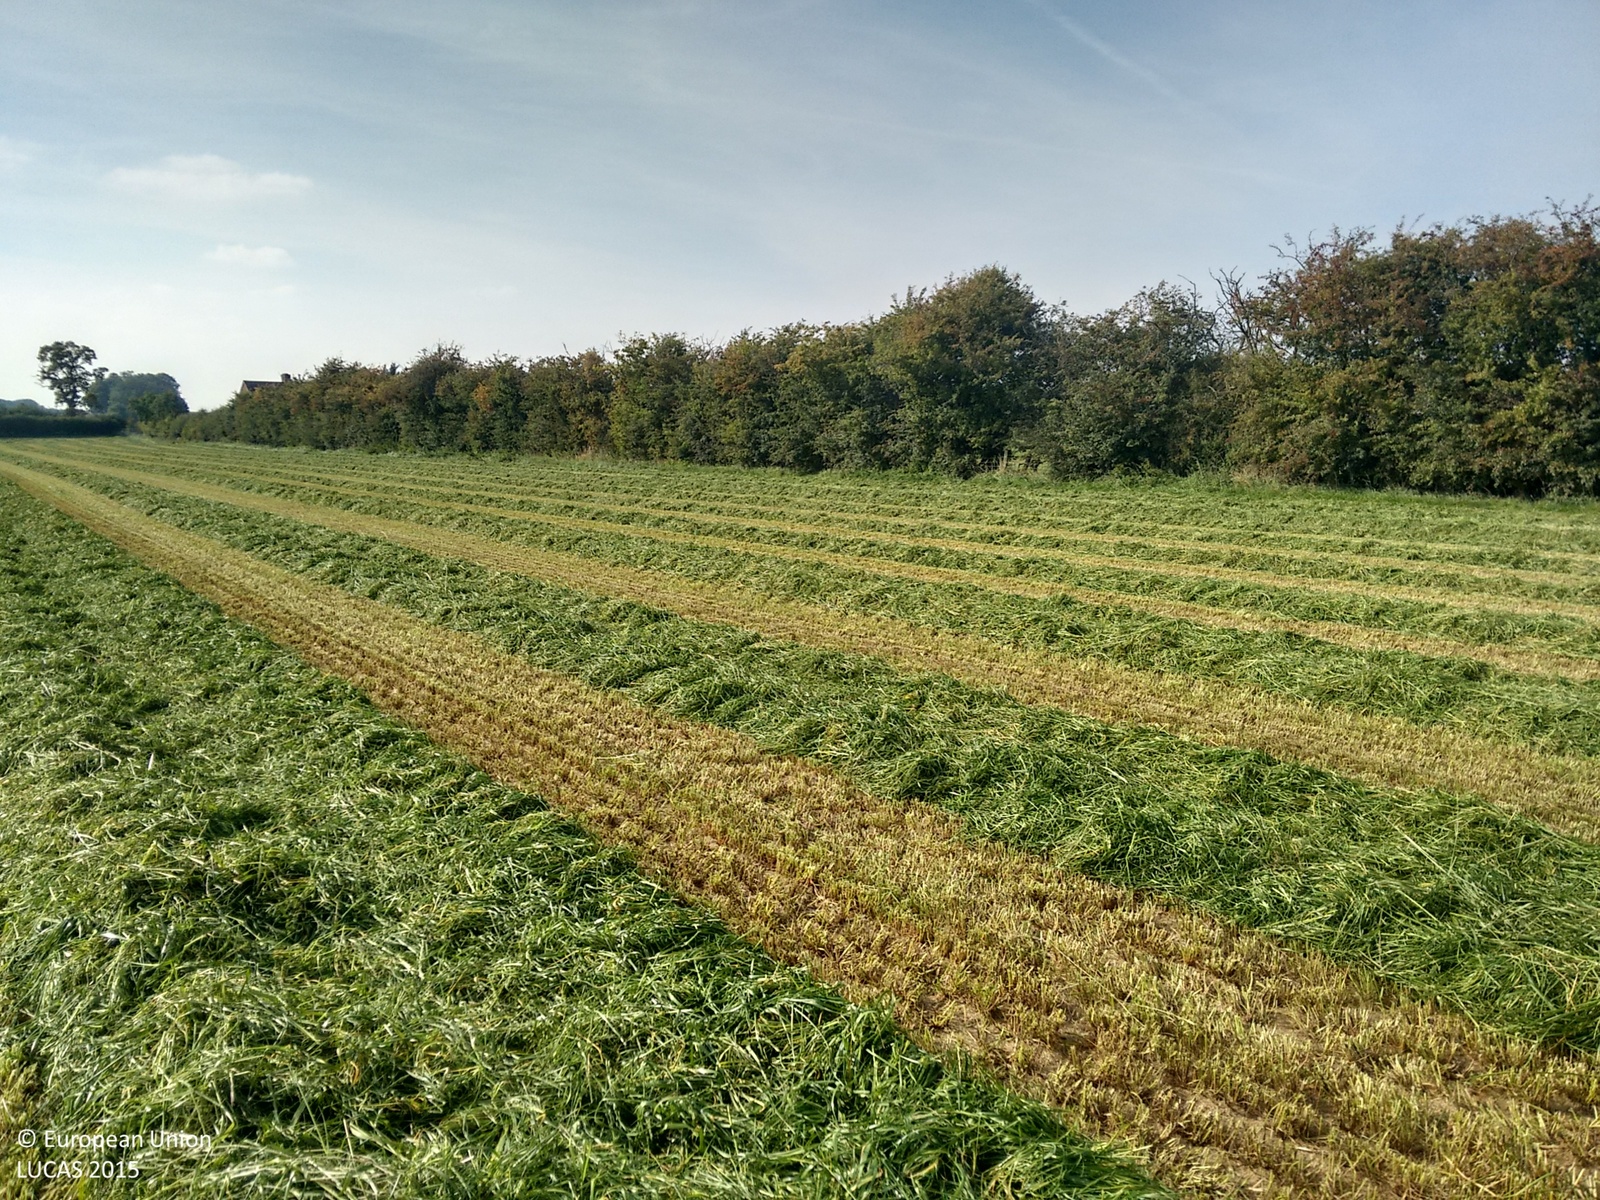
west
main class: Grassland
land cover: Grassland without tree/shrub cover
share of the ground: > 75 %
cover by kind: herbaceous plants 100 %
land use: Agriculture (excluding fallow land and kitchen gardens)
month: September
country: GB
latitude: 52.7698
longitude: -2.3208
